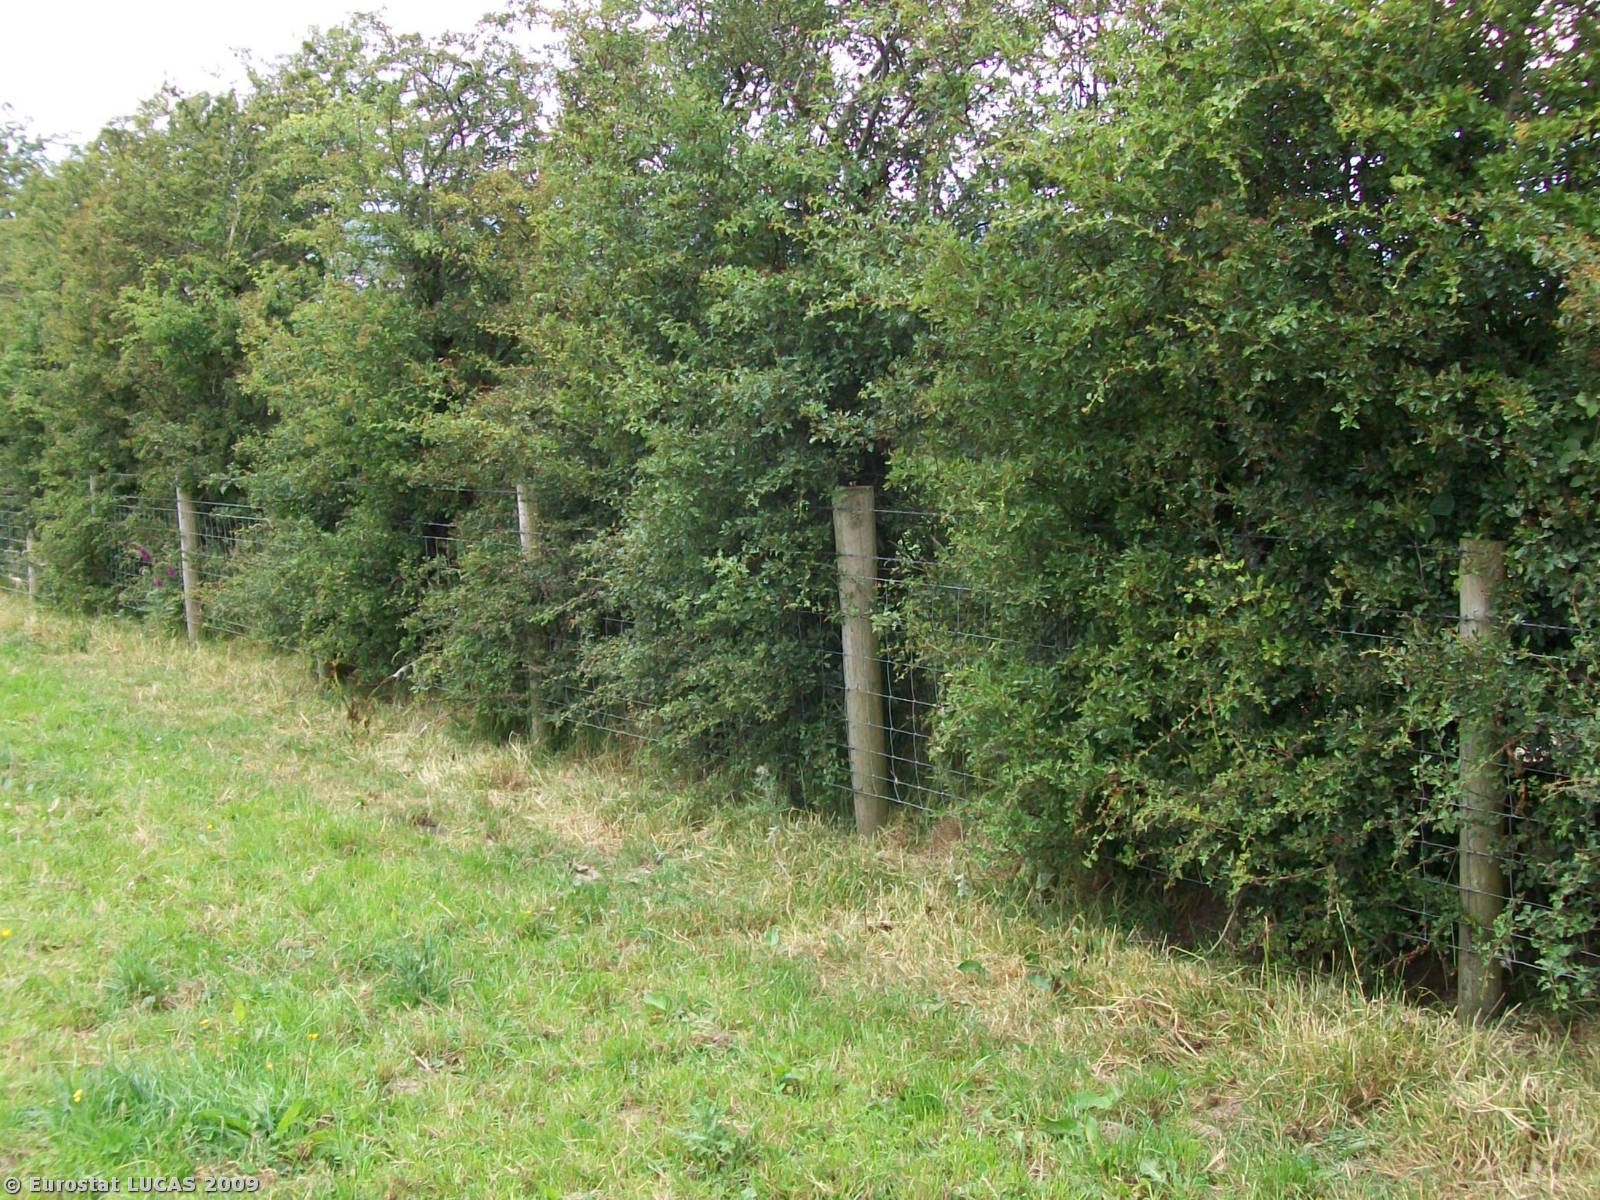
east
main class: Grassland
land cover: Grassland without tree/shrub cover
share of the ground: > 75 %
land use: Agriculture (excluding fallow land and kitchen gardens)
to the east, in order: Grassland without tree/shrub cover; Rivers and streams; Managed hedges; Grassland without tree/shrub cover; Managed hedges; Grassland without tree/shrub cover; Tracks; Grassland without tree/shrub cover; Tracks; Grassland without tree/shrub cover
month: June
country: GB
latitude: 54.5220
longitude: -7.4100
